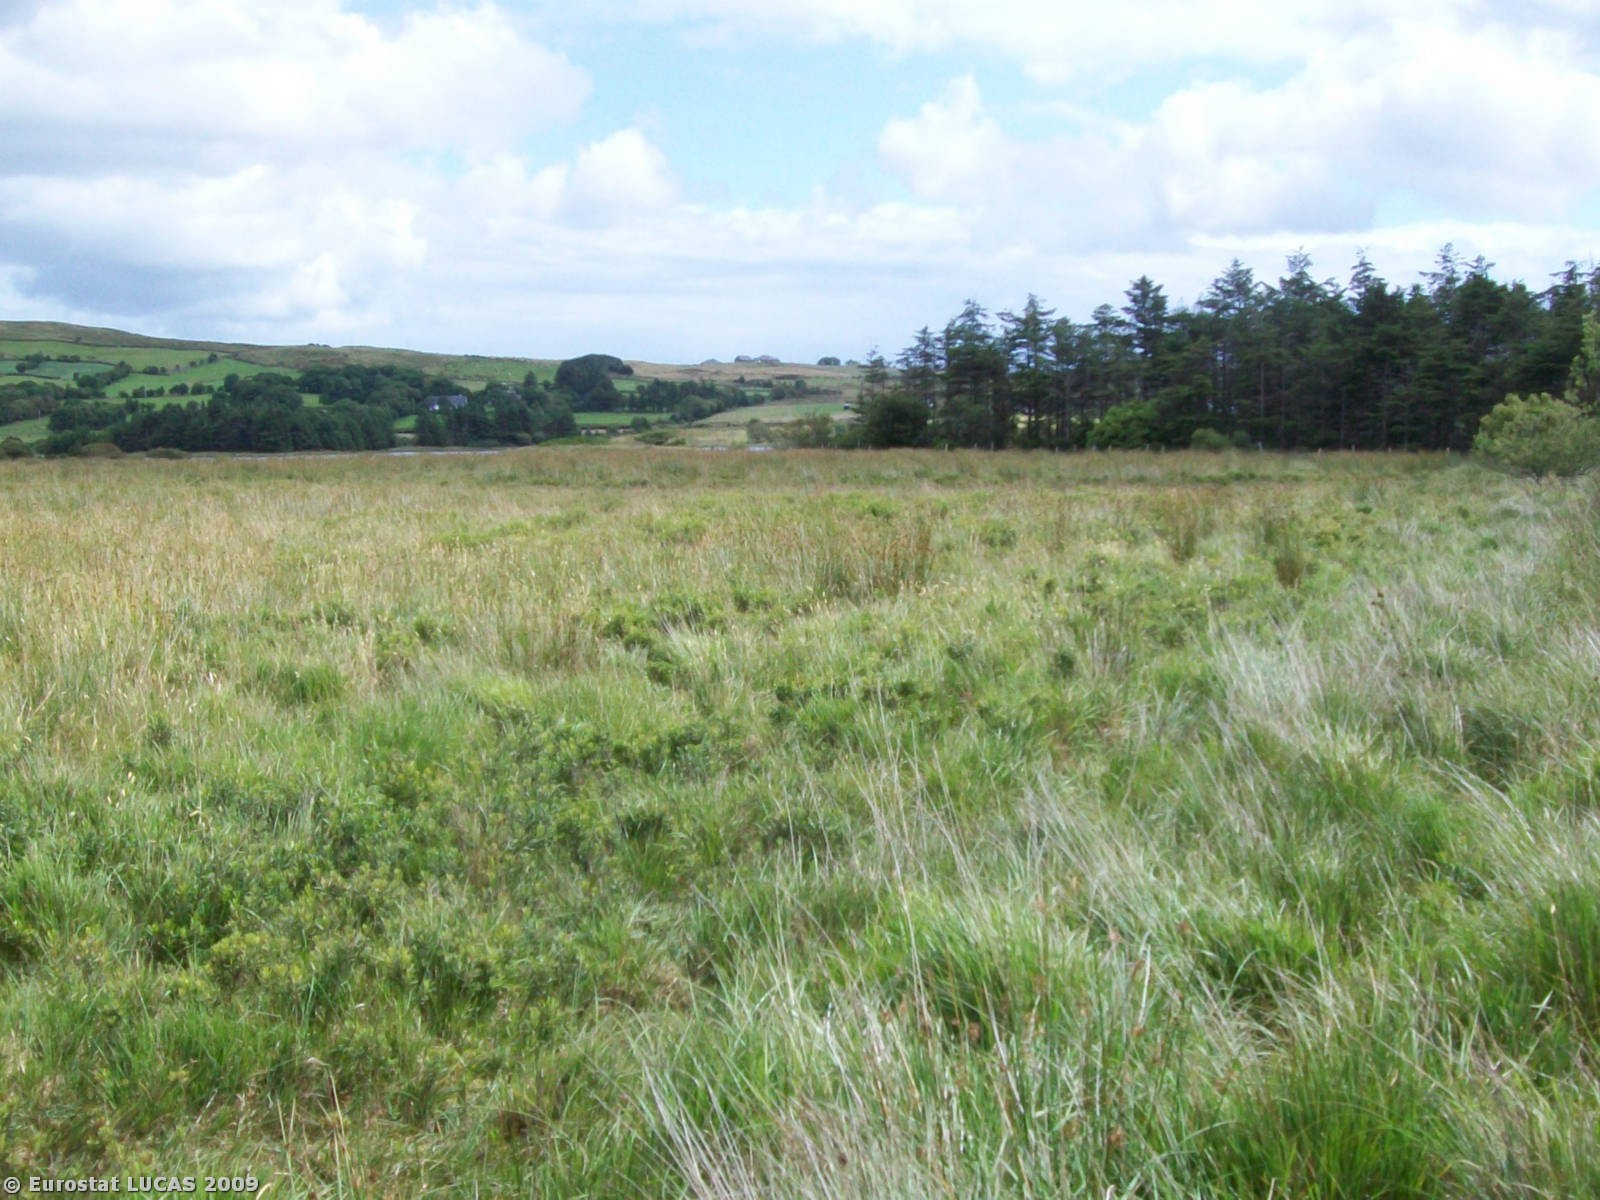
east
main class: Woodland
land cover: Mixed woodland
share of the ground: > 75 %
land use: Forestry
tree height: < 5 m
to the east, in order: Mixed woodland; Ditches and canals; Mixed woodland
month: July
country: IE
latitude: 53.7299
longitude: -9.5607
